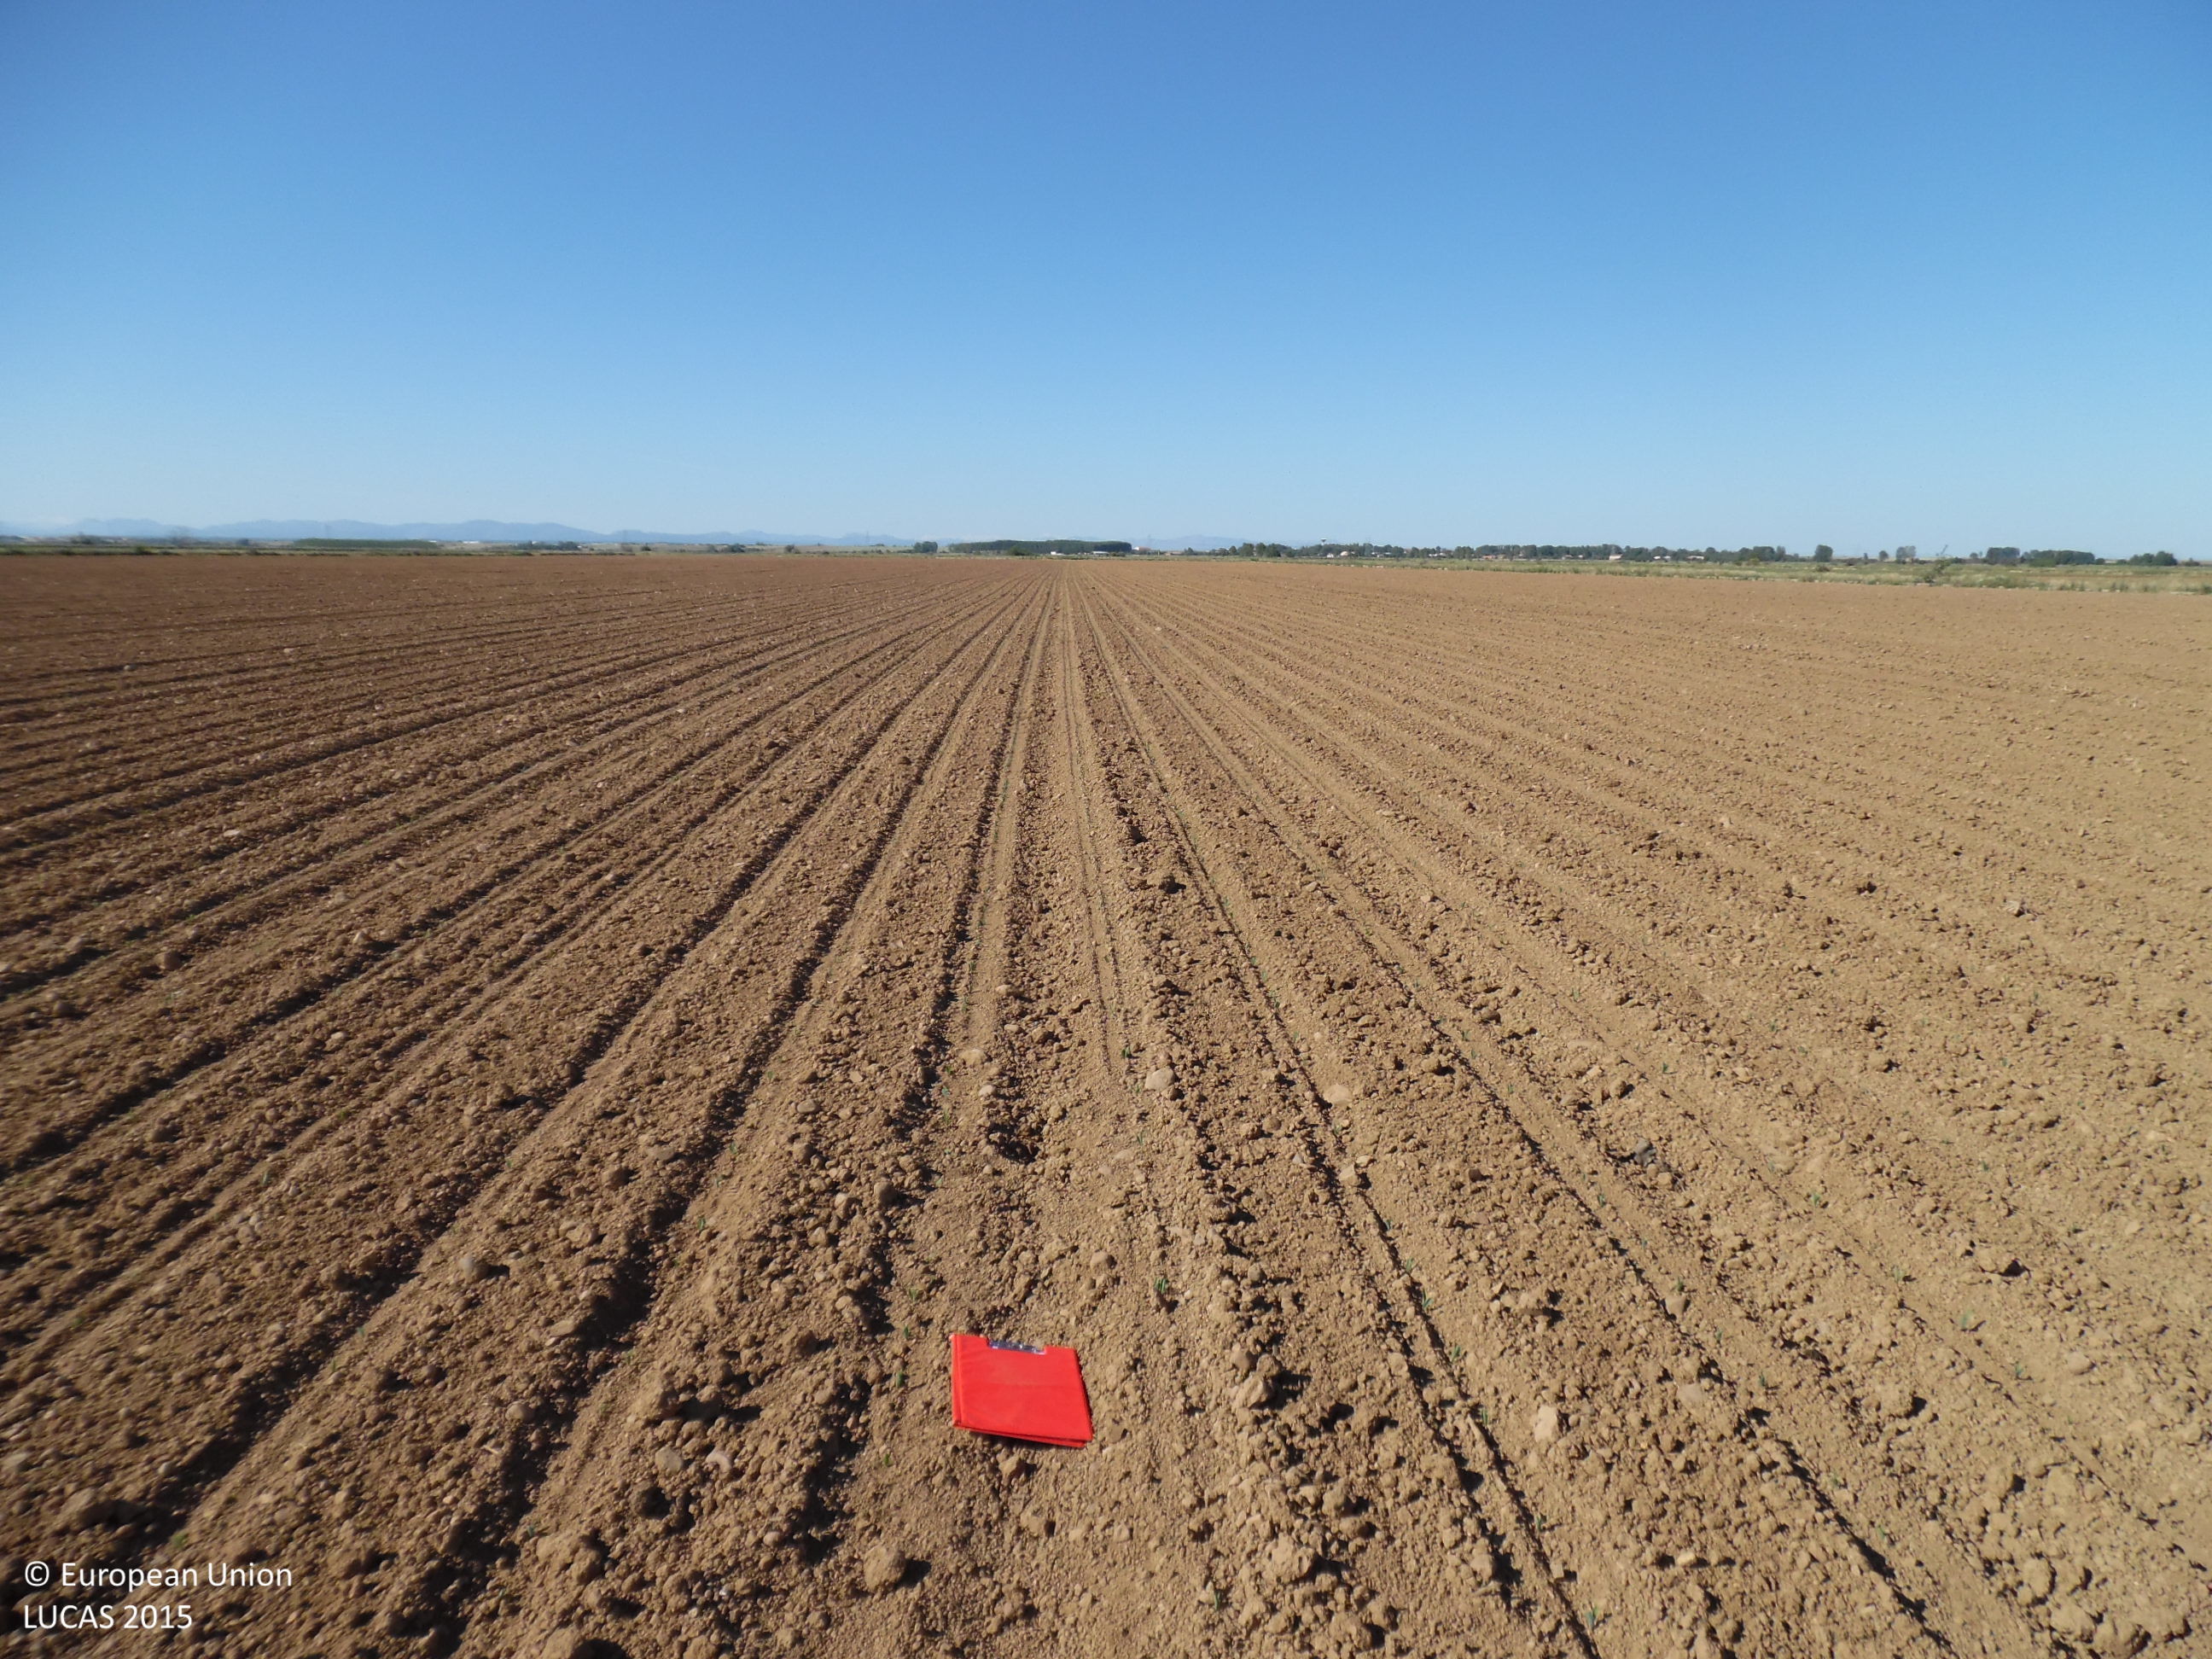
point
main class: Cropland
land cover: Maize
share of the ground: < 10 %
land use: Agriculture (excluding fallow land and kitchen gardens)
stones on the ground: 10 - 25 %
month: June
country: ES
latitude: 42.4595
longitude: -5.7500
